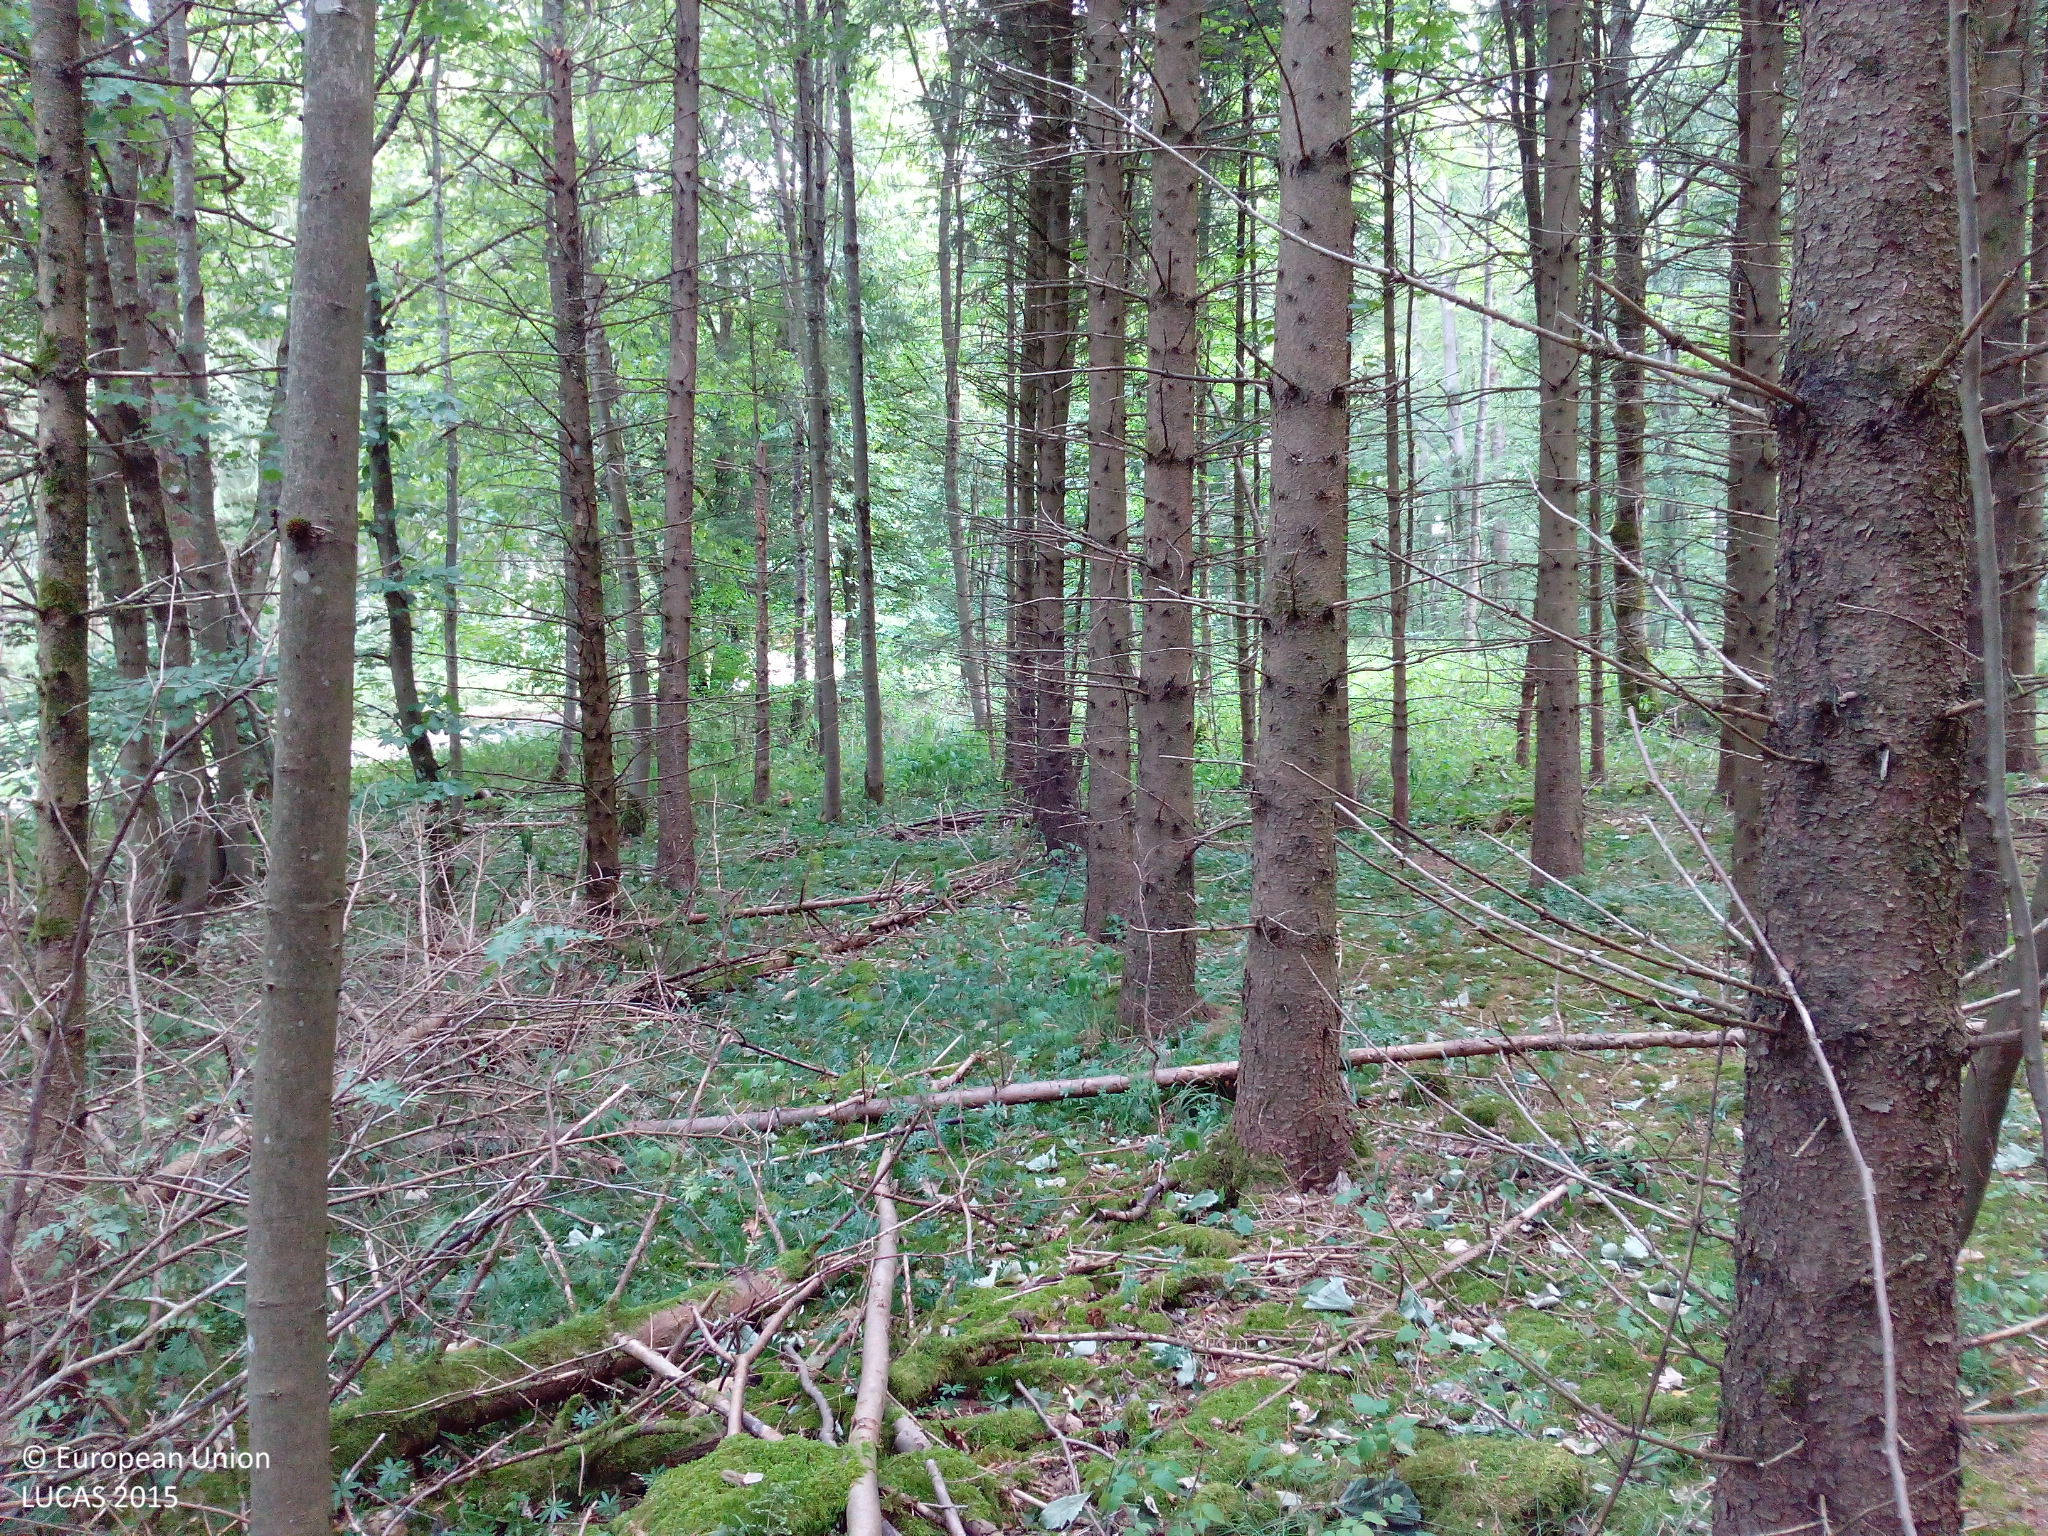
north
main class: Woodland
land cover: Spruce dominated mixed woodland
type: hemiboreal forest and nemoral coniferous forest and mixed broadleaved-coniferous forest
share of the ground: > 75 %
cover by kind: coniferous forest trees 45 %, broadleaved forest trees 30 %, lichens and mosses 15 %, shrubs 5 %, herbaceous plants 5 %
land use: Forestry
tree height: > 5 m
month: July
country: DE
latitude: 48.8169
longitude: 10.3131
